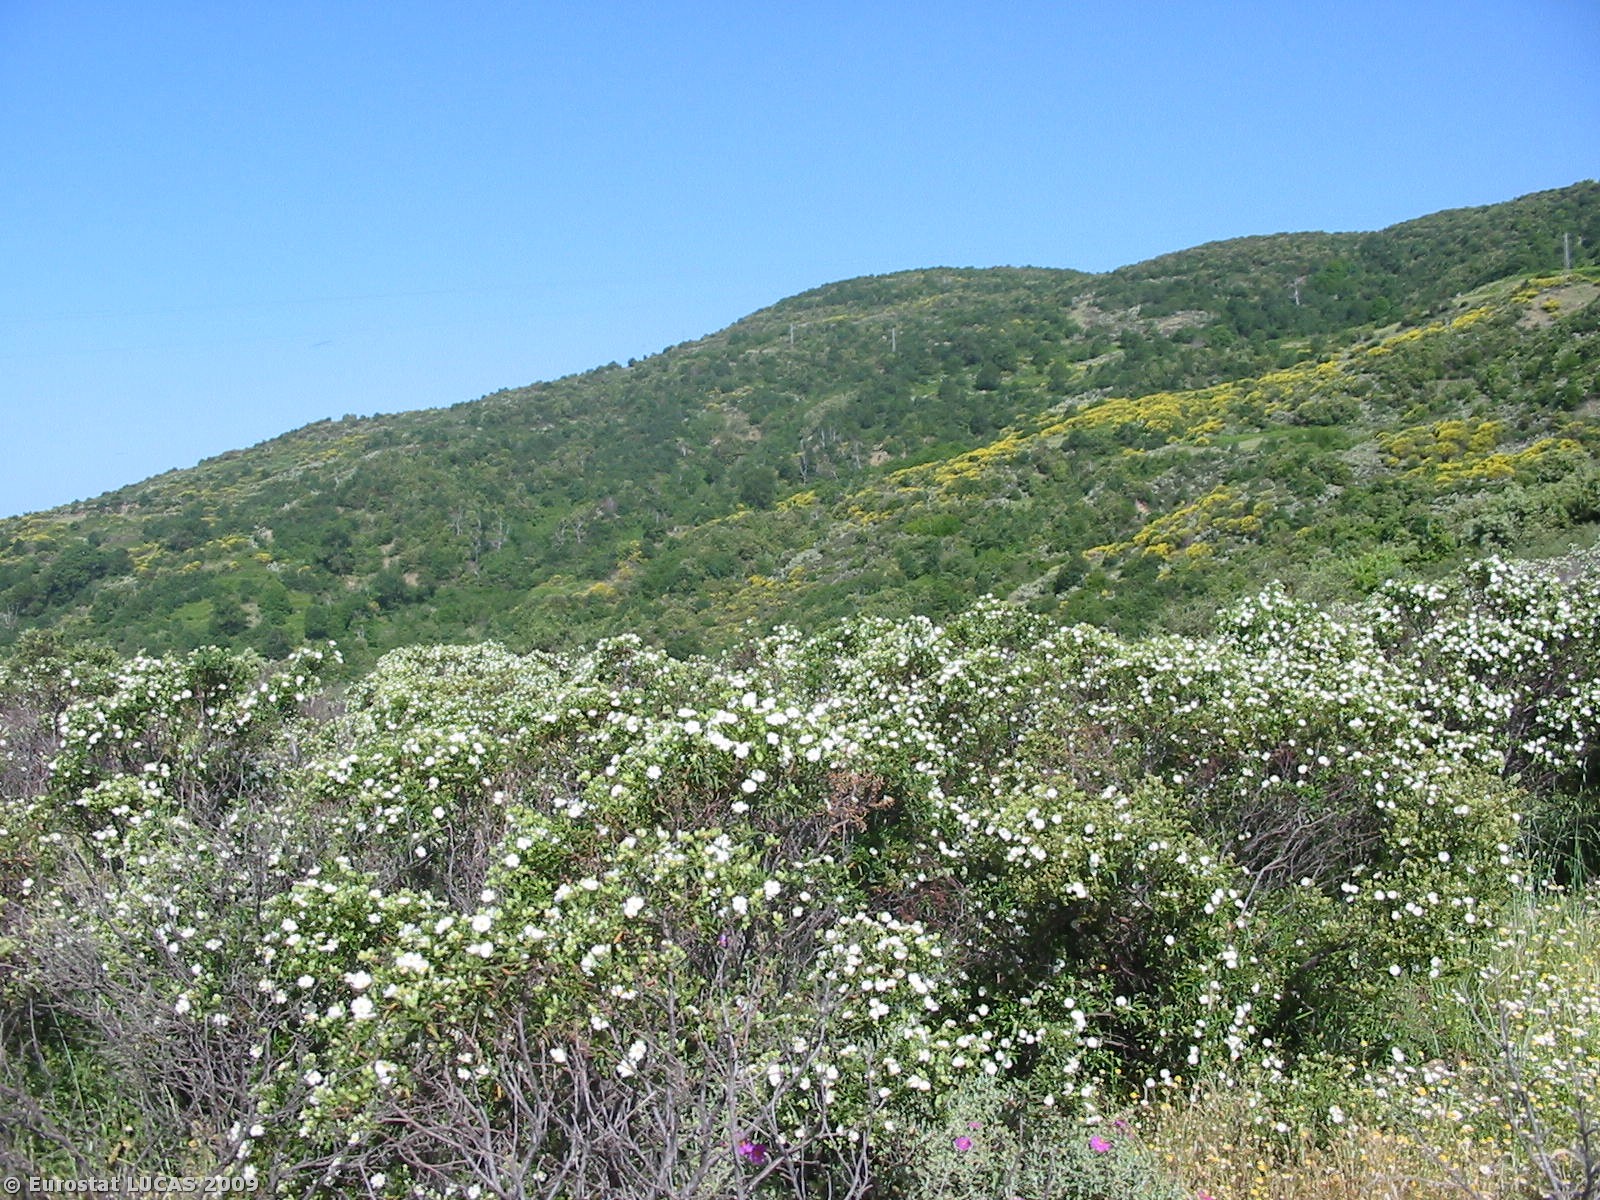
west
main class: Woodland
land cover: Broadleaved woodland
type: broadleaved evergreen forest
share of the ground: > 75 %
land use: Unused
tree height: > 5 m
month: May
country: IT
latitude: 38.3712
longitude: 16.3615
